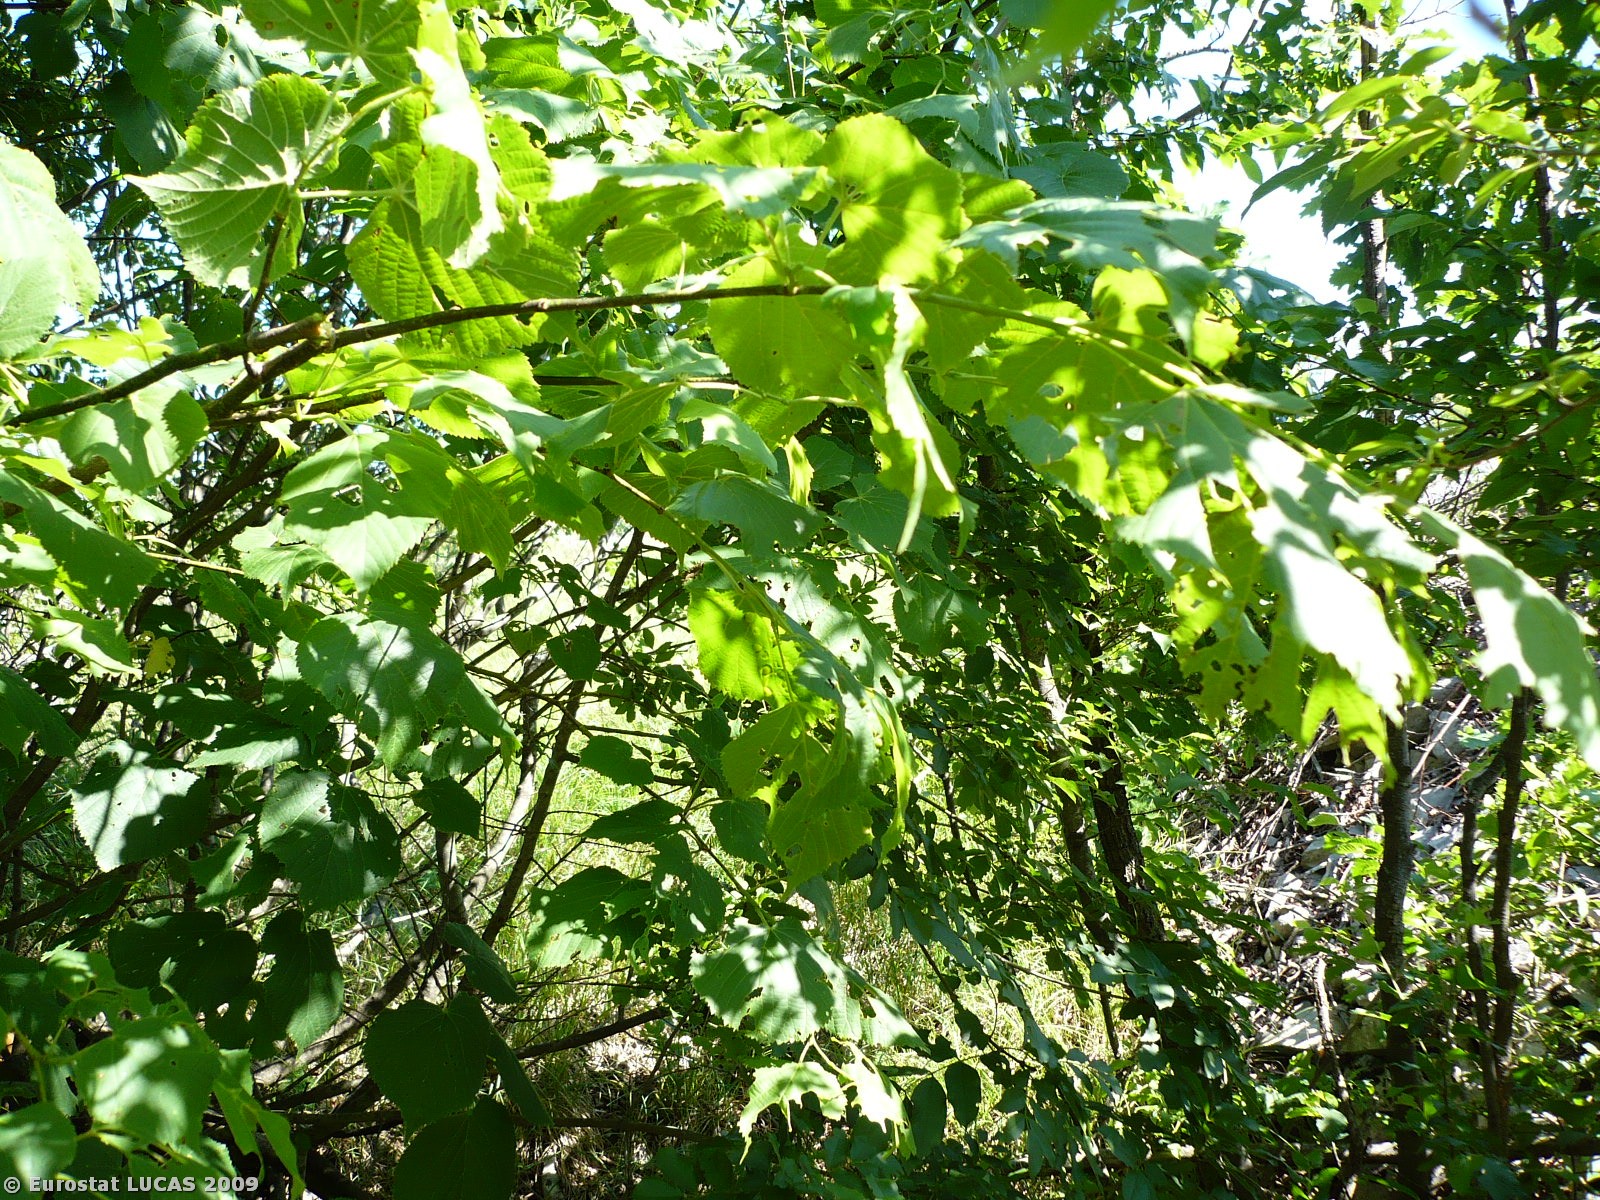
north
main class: Woodland
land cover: Broadleaved woodland
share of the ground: 50 - 75 %
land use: Unused
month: June
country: SI
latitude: 45.8151
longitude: 13.7924
